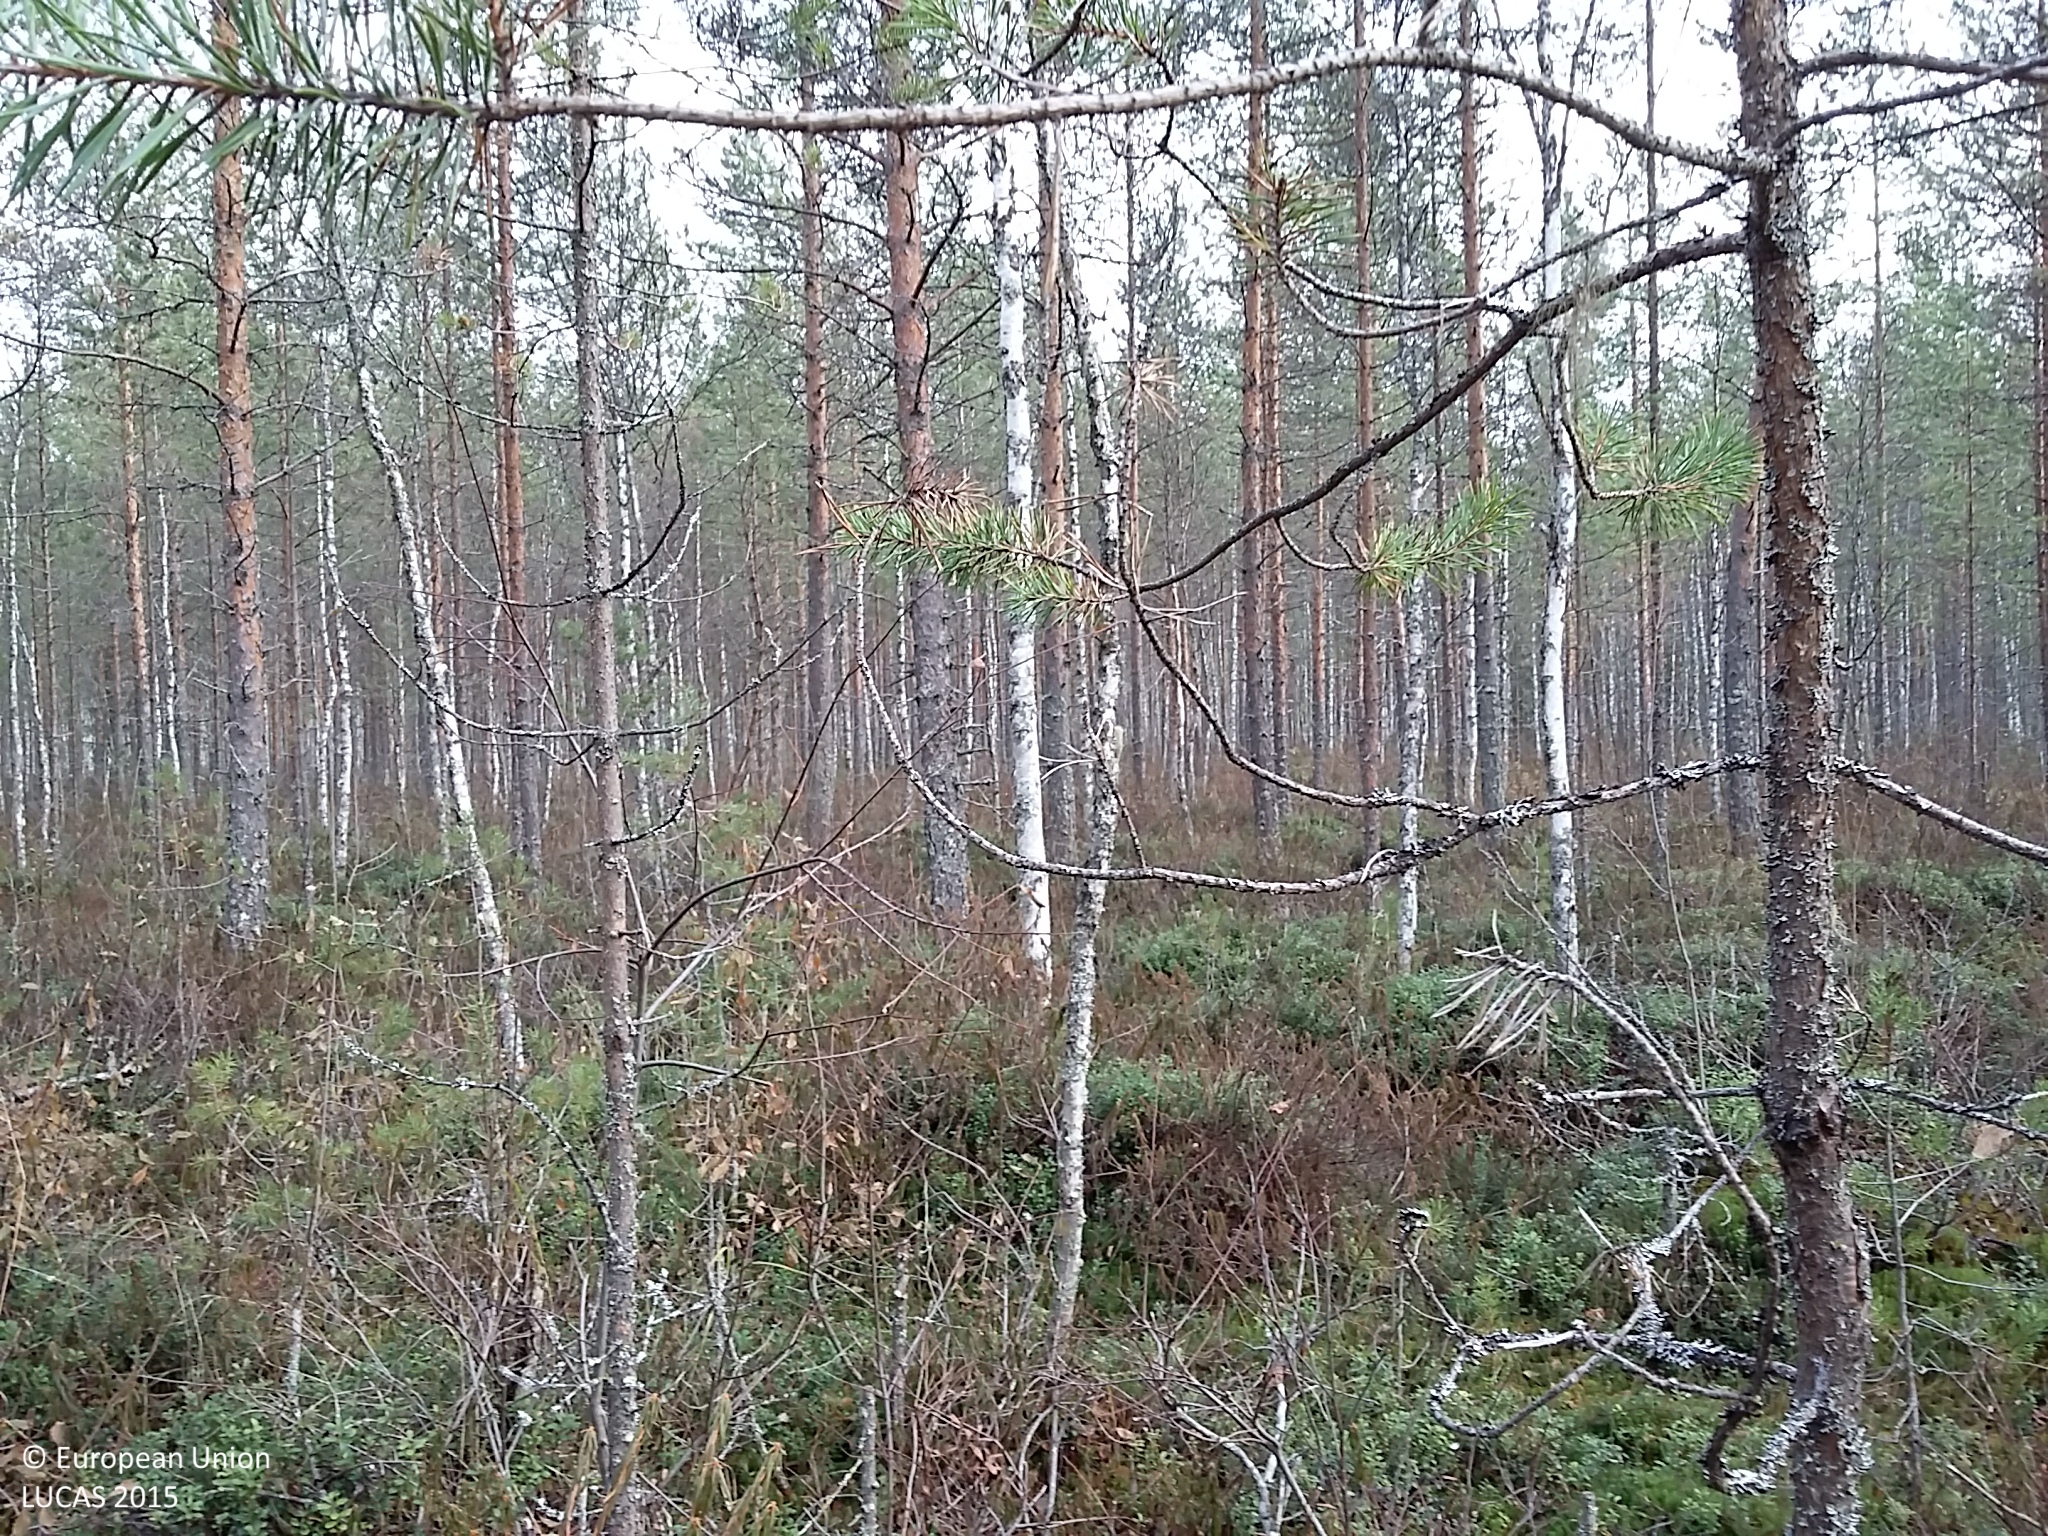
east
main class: Woodland
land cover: Pine dominated mixed woodland
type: boreal forest
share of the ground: > 75 %
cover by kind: coniferous forest trees 55 %, broadleaved forest trees 25 %, shrubs 10 %, herbaceous plants 5 %, lichens and mosses 5 %
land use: Forestry
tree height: > 5 m
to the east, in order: Pine dominated mixed woodland; Ditches and canals; Pine dominated mixed woodland; Pine dominated coniferous woodland; Ditches and canals; Pine dominated mixed woodland; Ditches and canals; Pine dominated mixed woodland; Ditches and canals; Pine dominated mixed woodland; Ditches and canals; Pine dominated mixed woodland; Ditches and canals; Pine dominated coniferous woodland
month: October
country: FI
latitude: 64.6198
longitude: 25.5848
